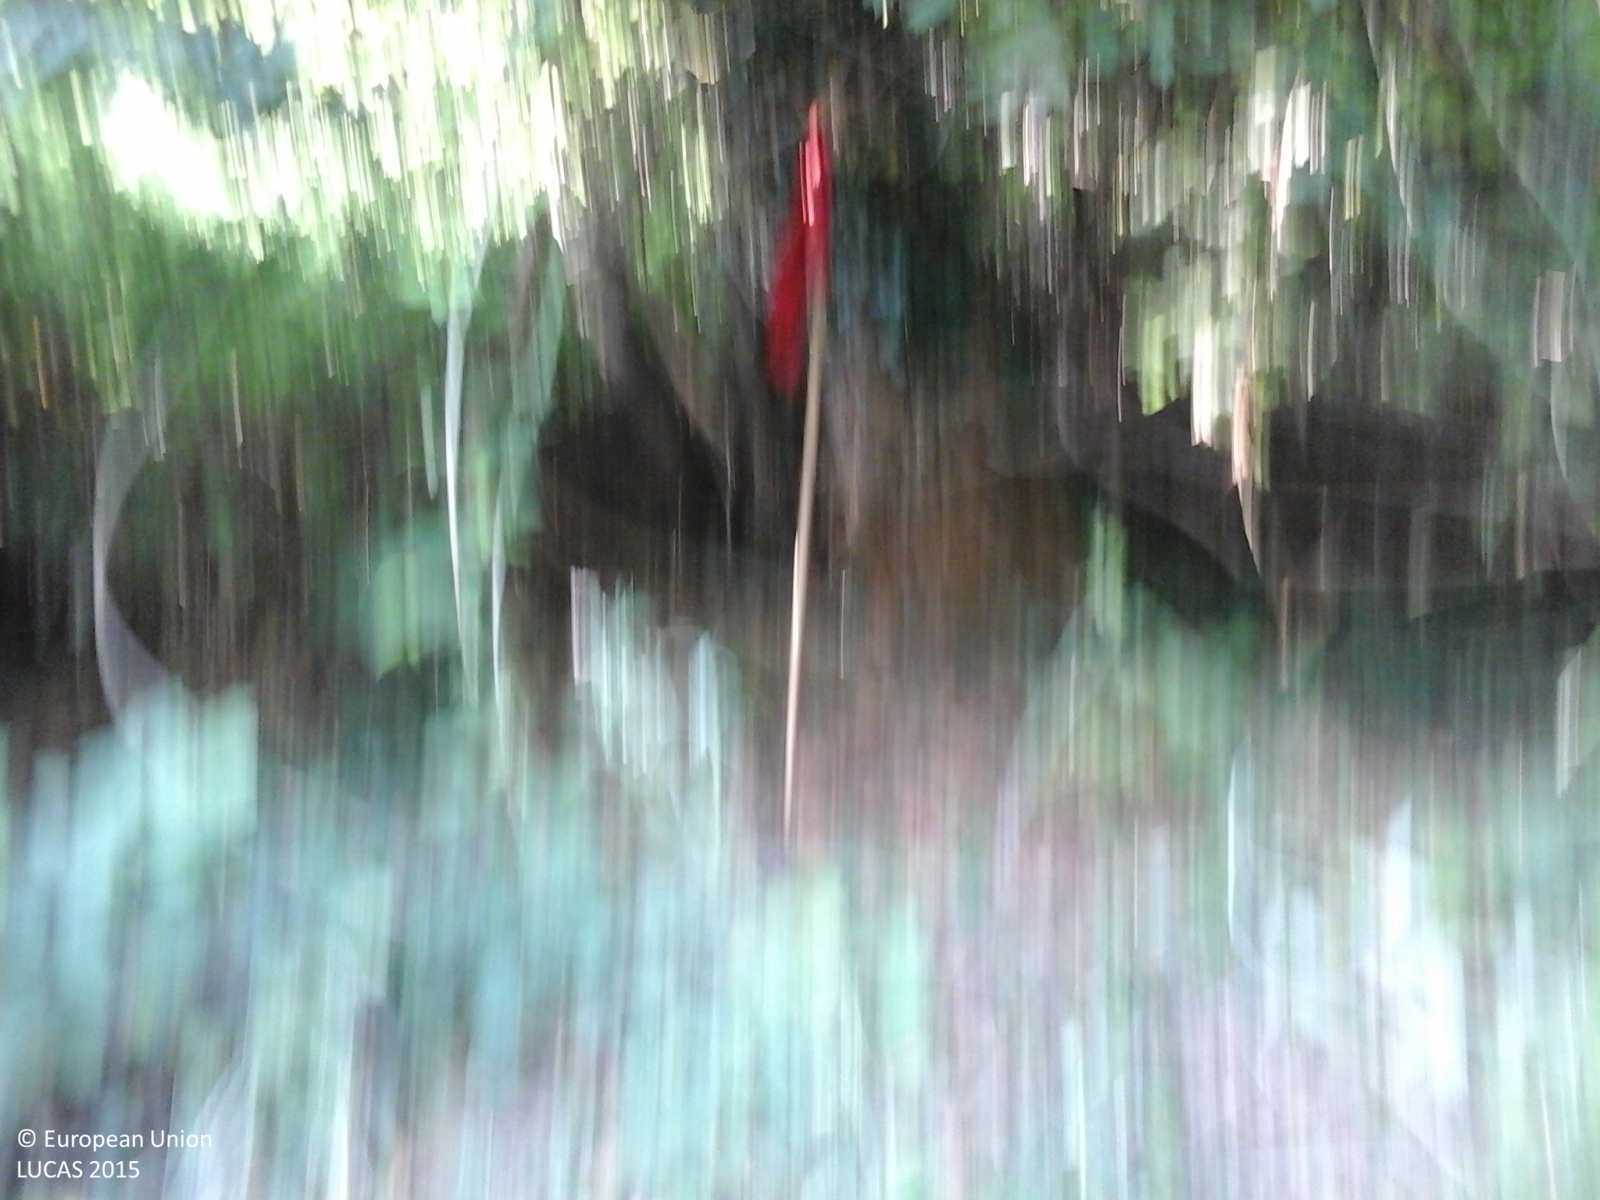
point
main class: Woodland
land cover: Broadleaved woodland
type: thermophilous deciduous forest
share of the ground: > 75 %
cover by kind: broadleaved forest trees 100 %
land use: Semi-natural and natural areas not in use
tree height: > 5 m
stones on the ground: < 10 %
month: August
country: IT
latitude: 43.1359
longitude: 13.4945
